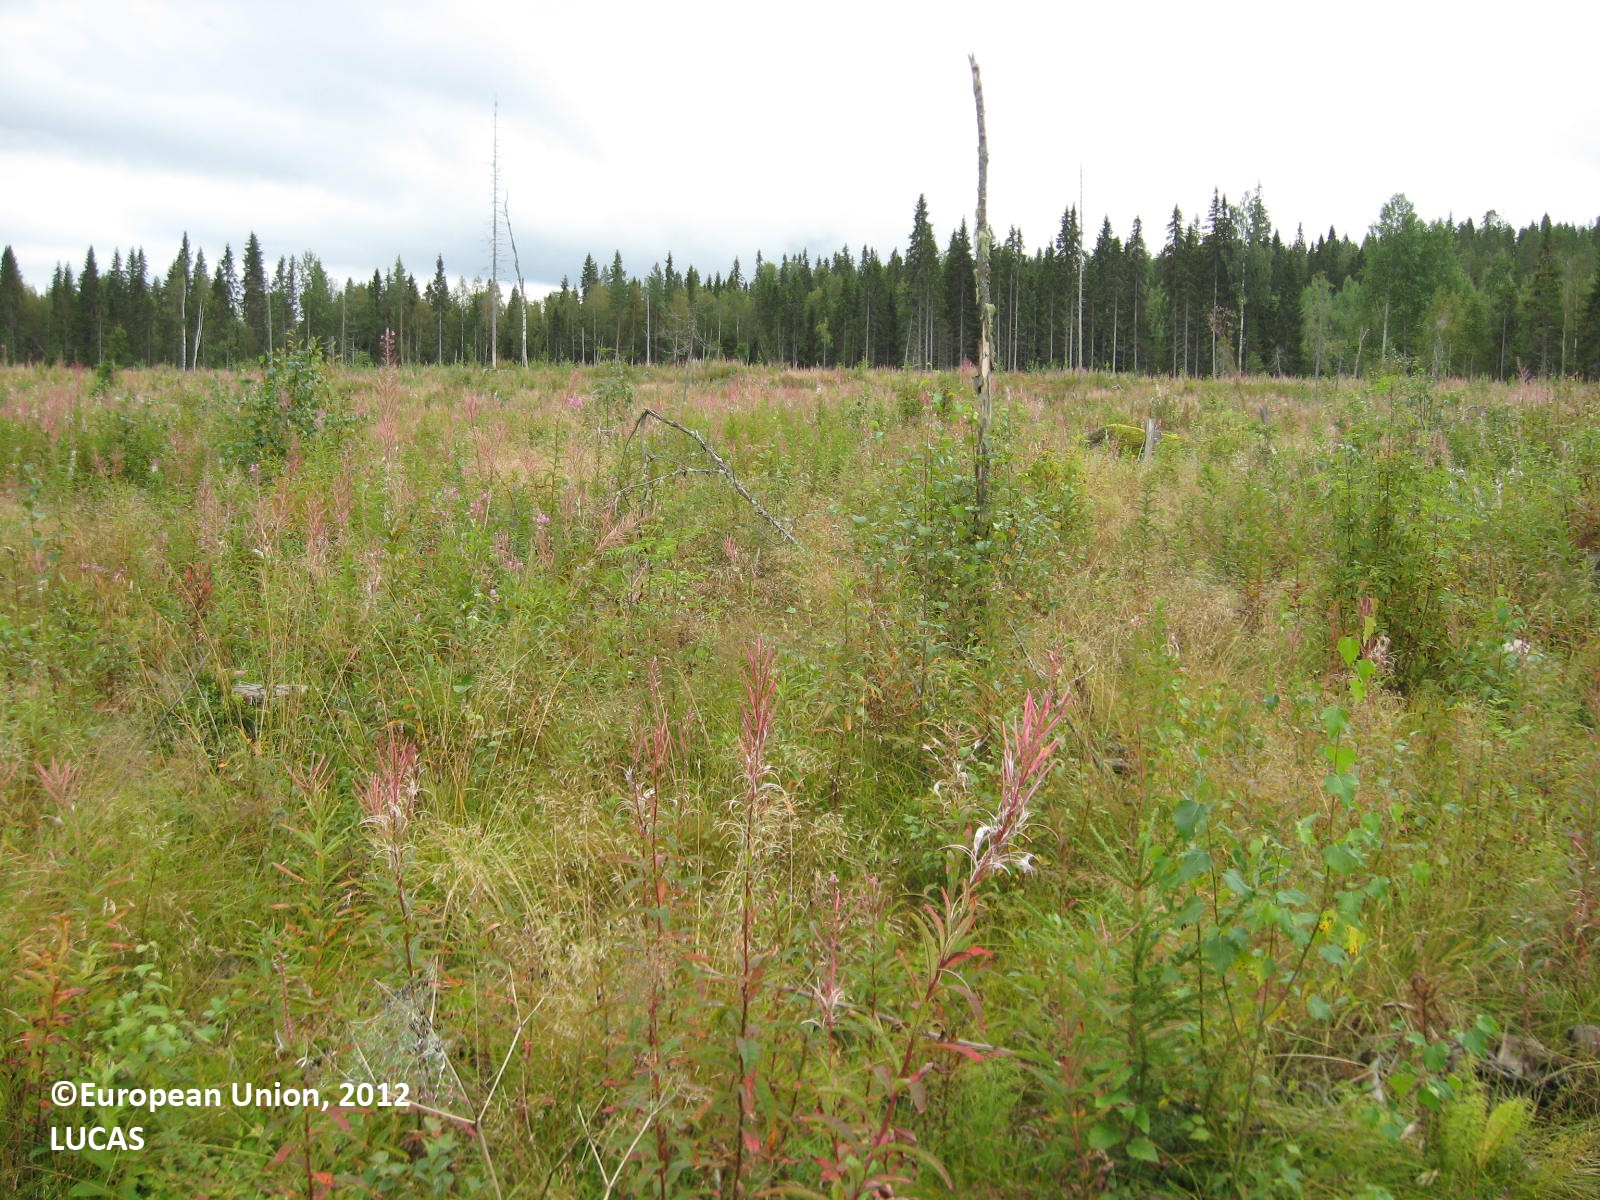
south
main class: Shrubland
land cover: Shrubland without tree cover
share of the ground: 50 - 75 %
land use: Forestry
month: August
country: FI
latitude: 63.6603
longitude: 29.0132
